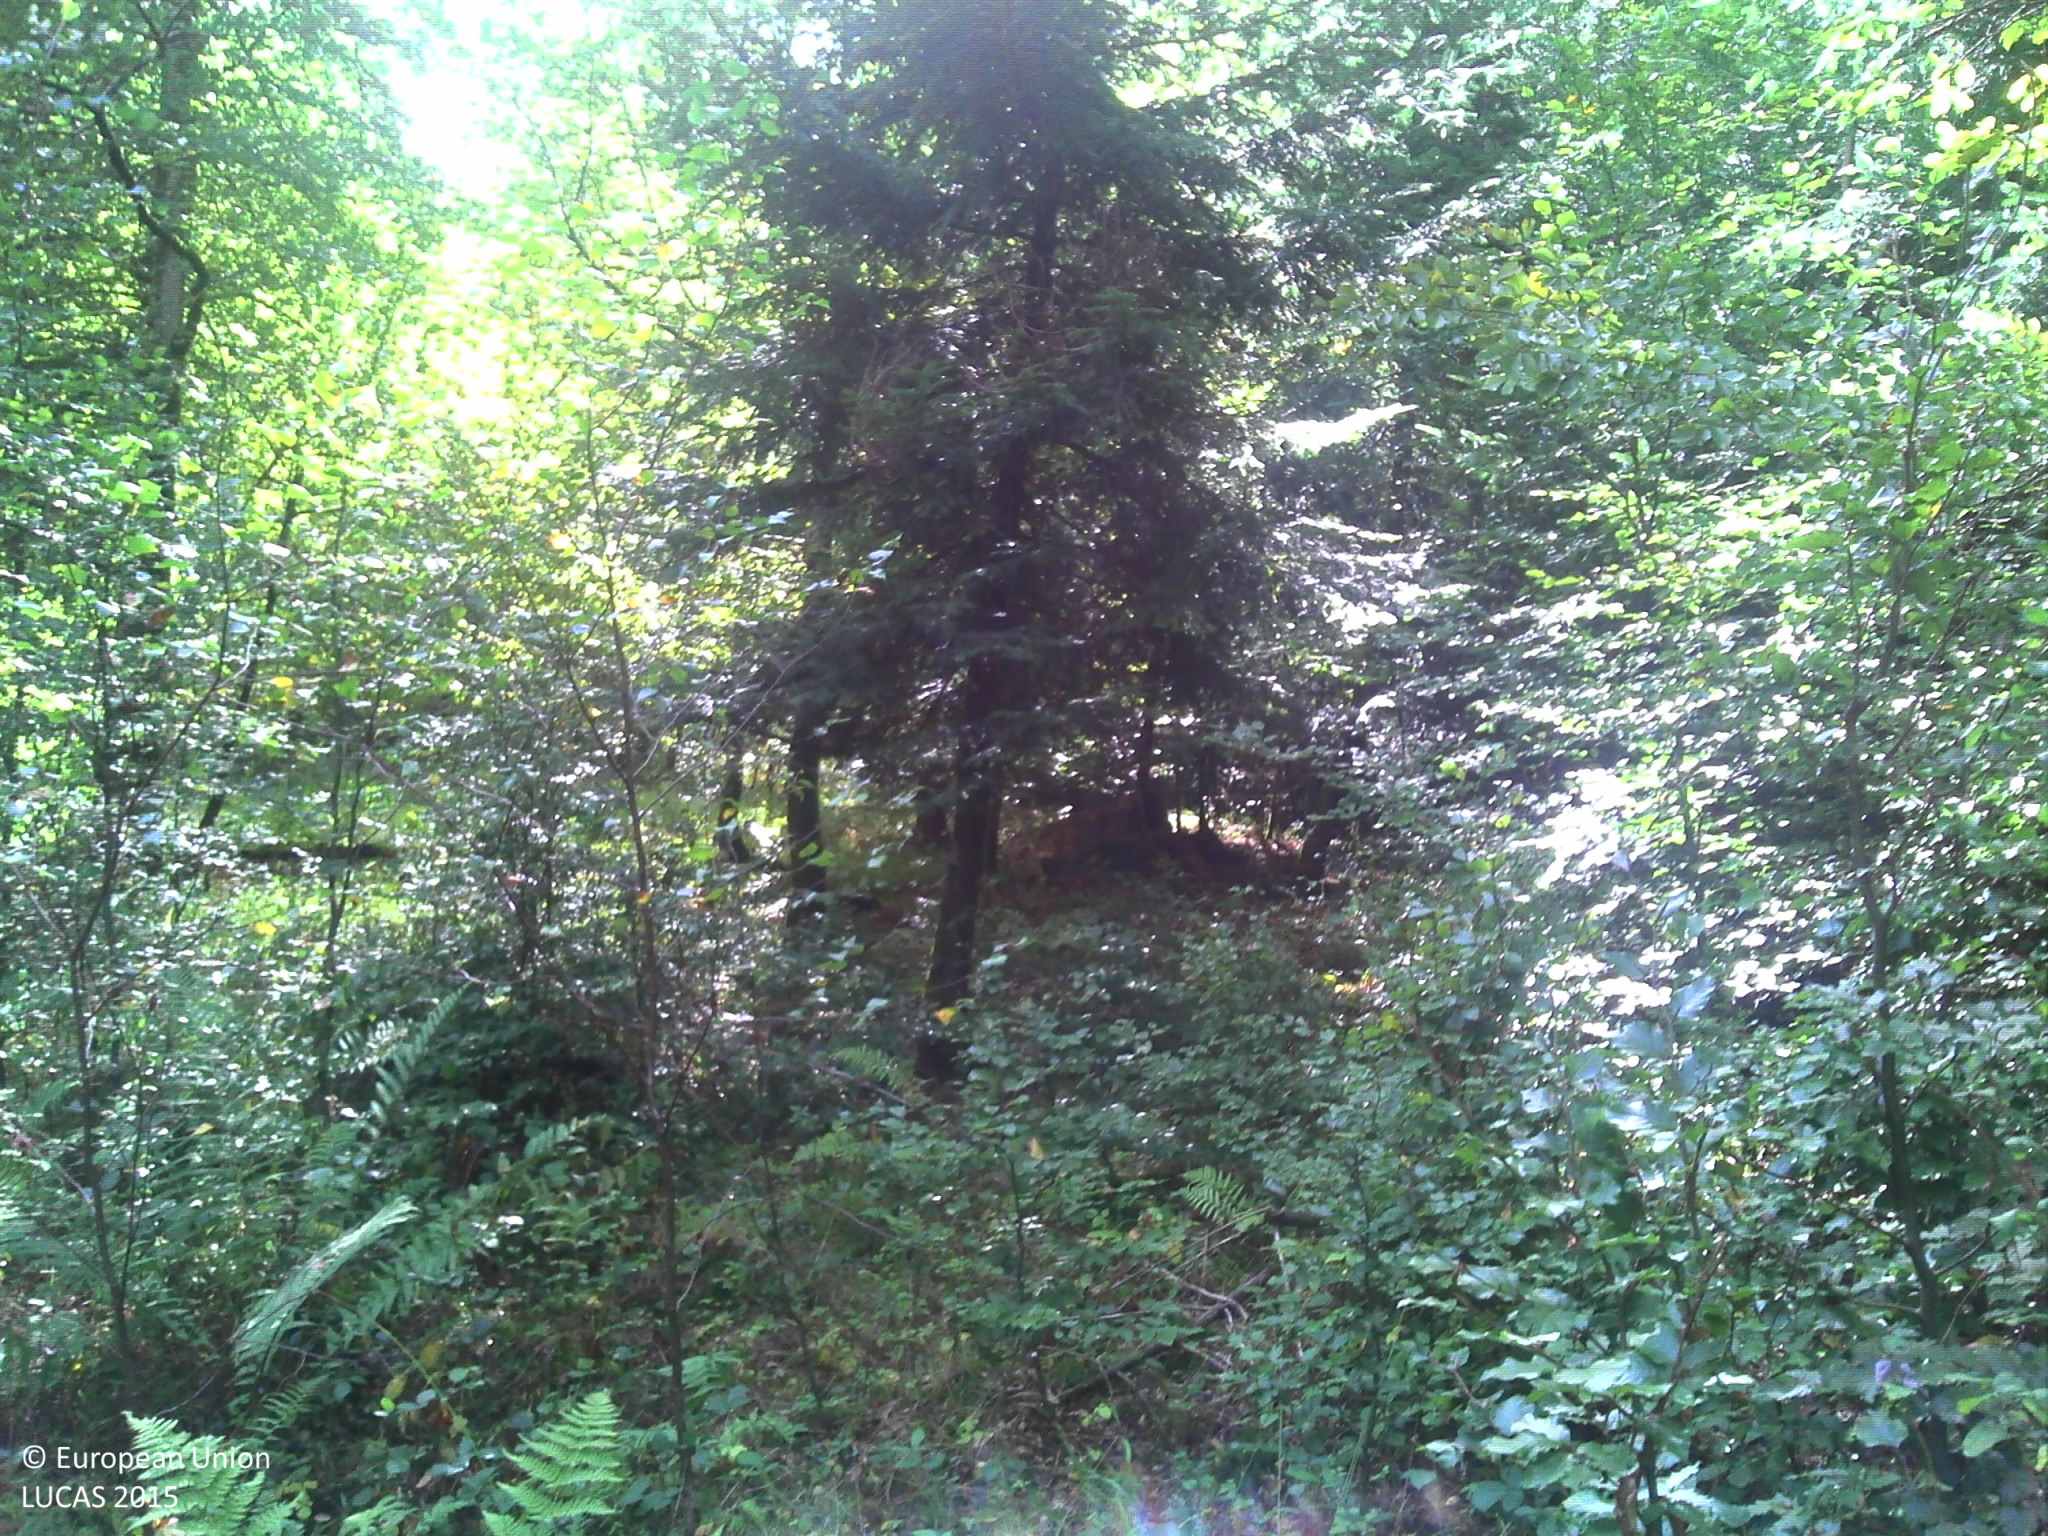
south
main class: Woodland
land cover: Other mixed woodland
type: hemiboreal forest and nemoral coniferous forest and mixed broadleaved-coniferous forest
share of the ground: > 75 %
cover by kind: broadleaved forest trees 55 %, coniferous forest trees 20 %, shrubs 10 %, herbaceous plants 10 %, lichens and mosses 5 %
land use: Forestry
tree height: > 5 m
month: September
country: FR
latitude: 48.4487
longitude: 6.8505
